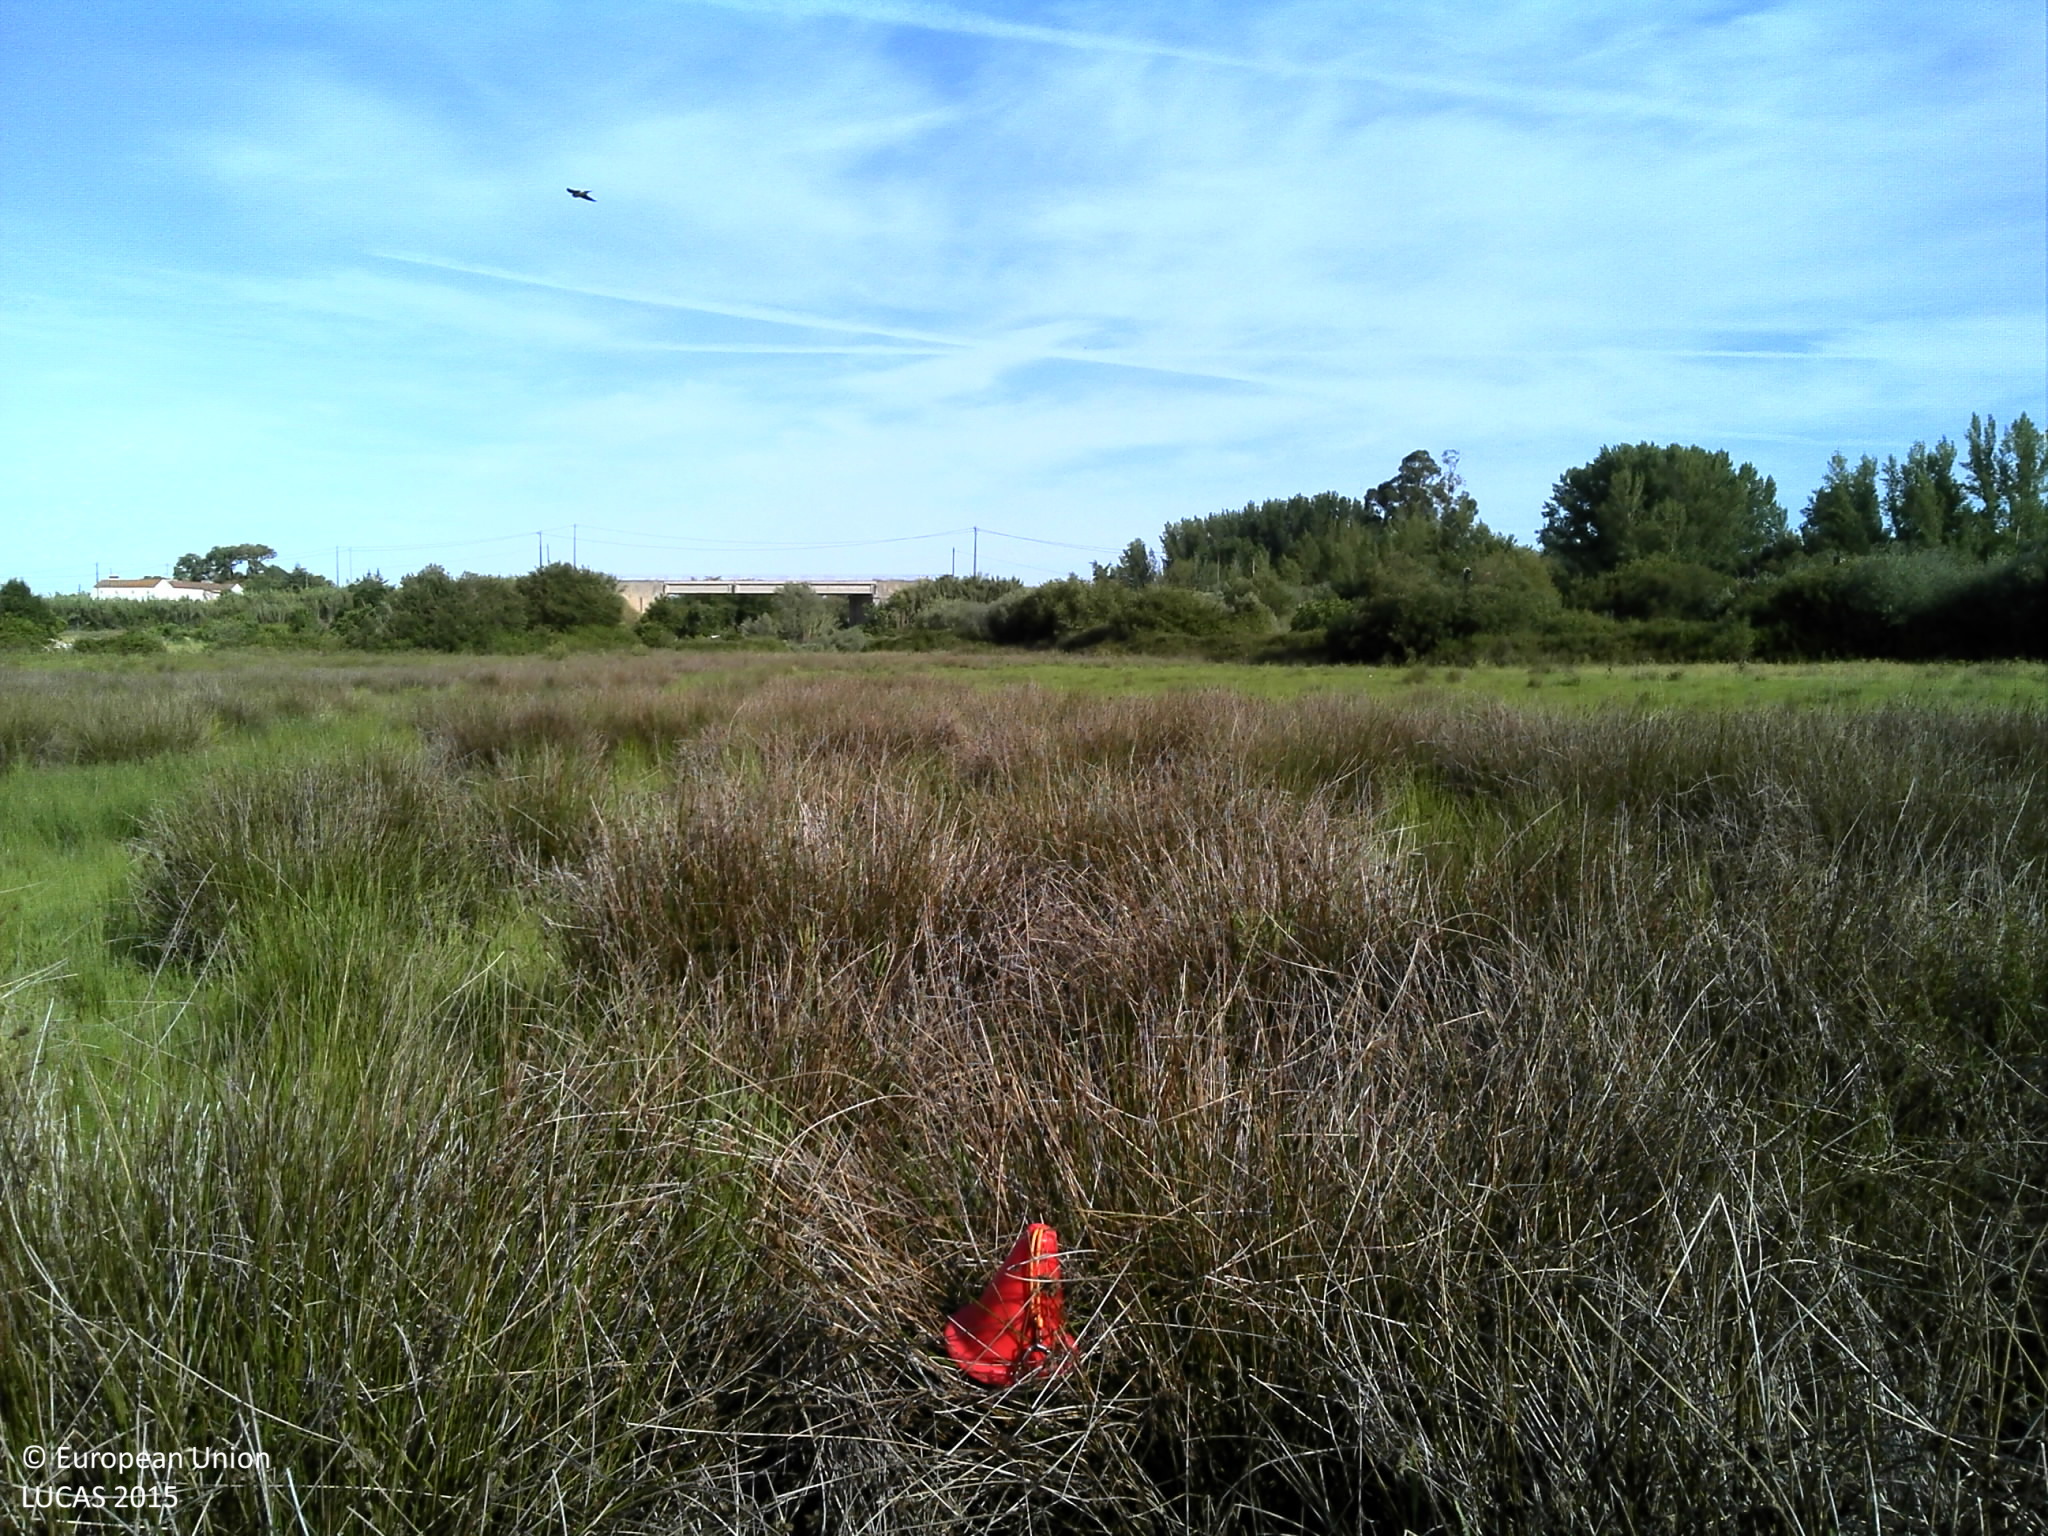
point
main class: Grassland
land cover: Grassland without tree/shrub cover
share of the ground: > 75 %
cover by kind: herbaceous plants 80 %, unconsolidated bare surface 20 %
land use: Agriculture (excluding fallow land and kitchen gardens)
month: May
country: PT
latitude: 39.3079
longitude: -7.9011
